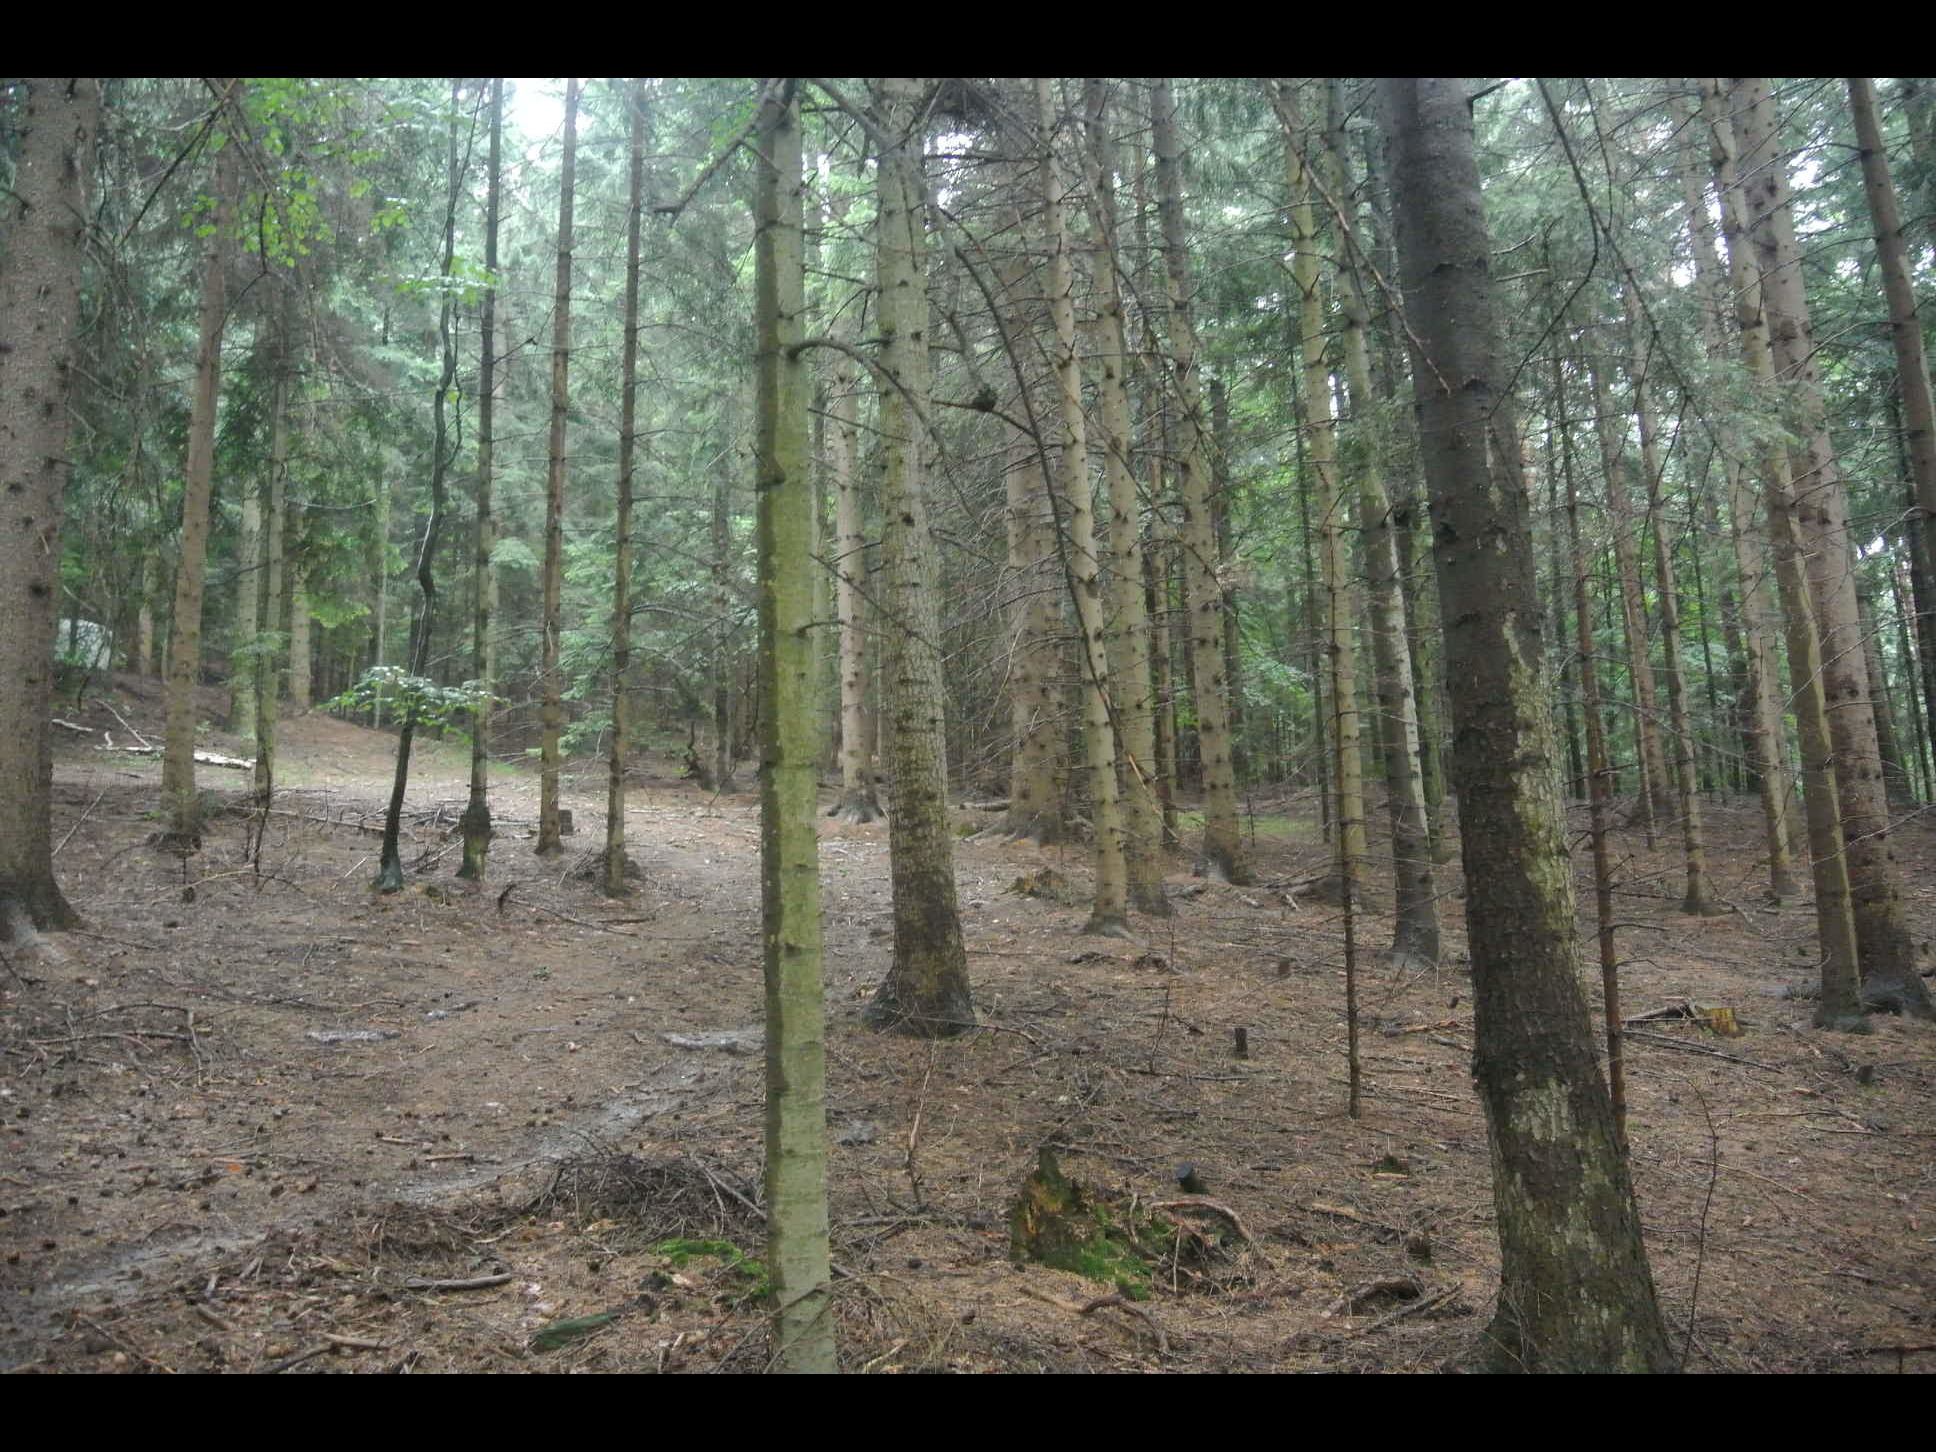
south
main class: Woodland
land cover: Spruce dominated coniferous woodland
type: alpine coniferous forest
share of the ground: > 75 %
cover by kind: coniferous forest trees 100 %
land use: Forestry
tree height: > 5 m
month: July
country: AT
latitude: 47.4566
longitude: 16.1439
